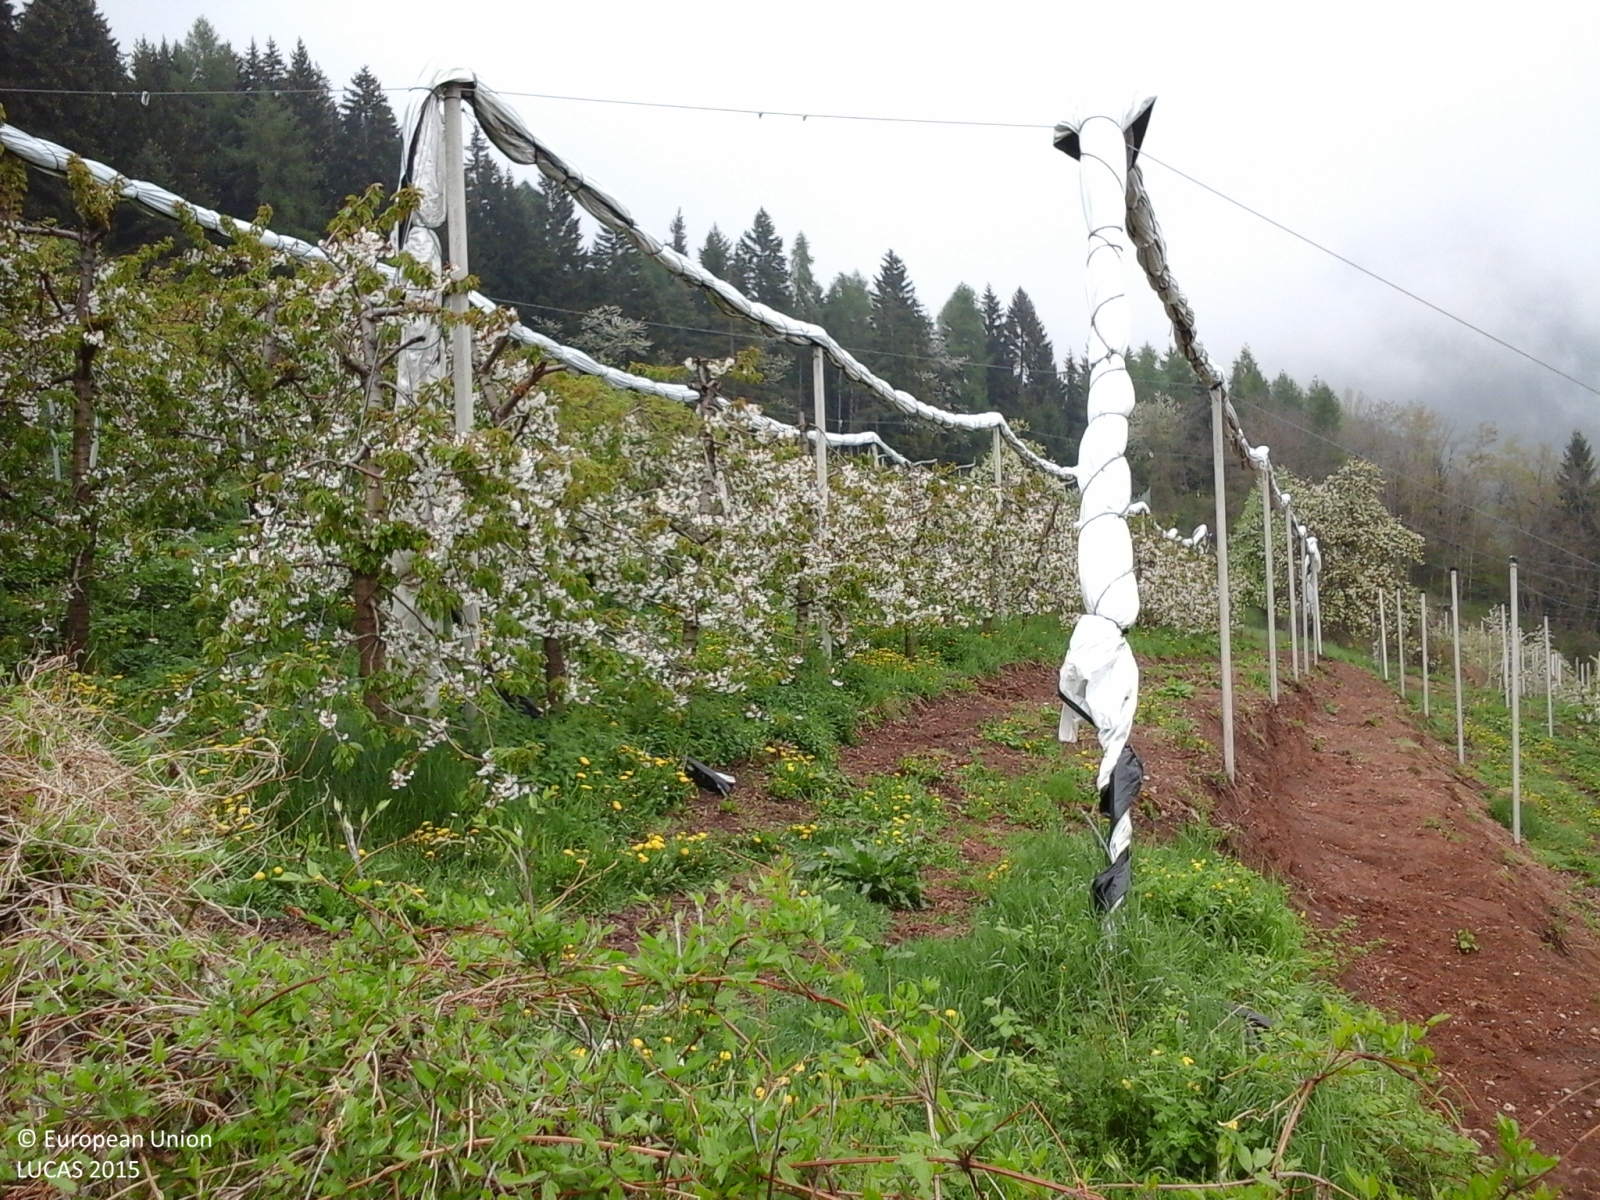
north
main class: Cropland
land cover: Apple fruit
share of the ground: 50 - 75 %
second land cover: Grassland without tree/shrub cover
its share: 25 - 50 %
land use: Agriculture (excluding fallow land and kitchen gardens)
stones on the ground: < 10 %
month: May
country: IT
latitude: 46.4536
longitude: 11.1052
